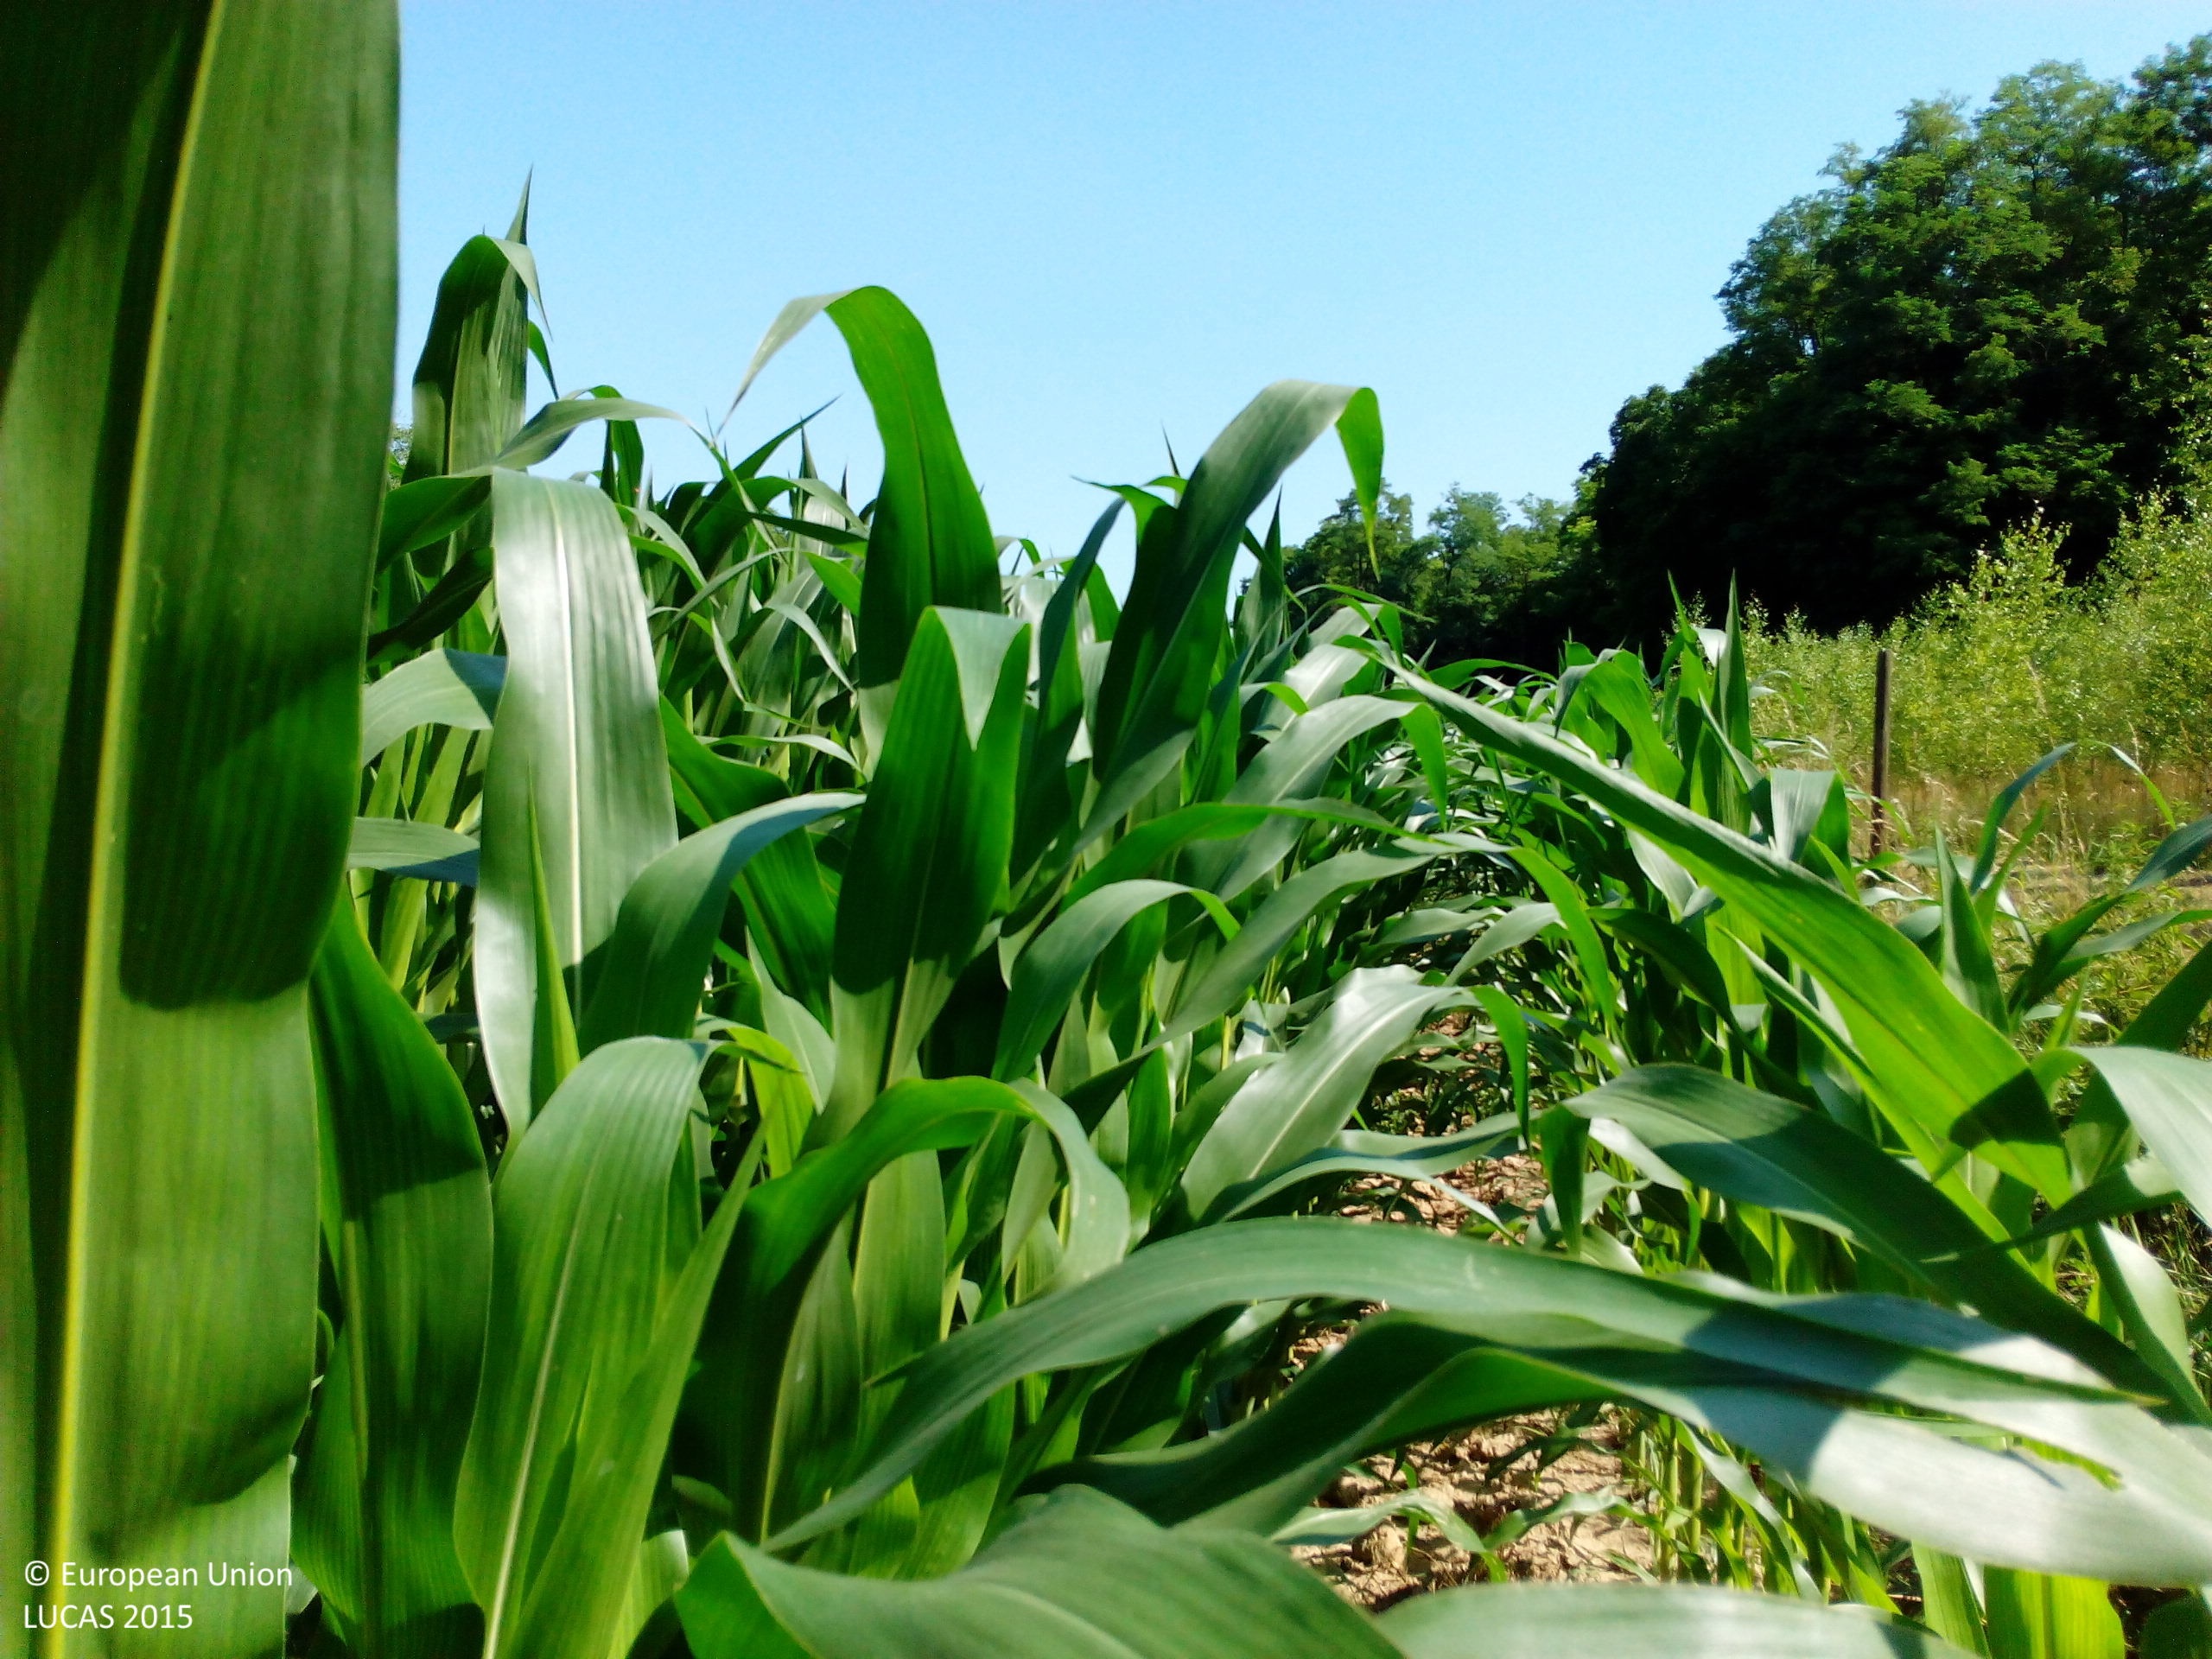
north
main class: Cropland
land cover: Maize
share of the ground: > 75 %
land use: Agriculture (excluding fallow land and kitchen gardens)
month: July
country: DE
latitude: 47.8381
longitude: 7.6364
